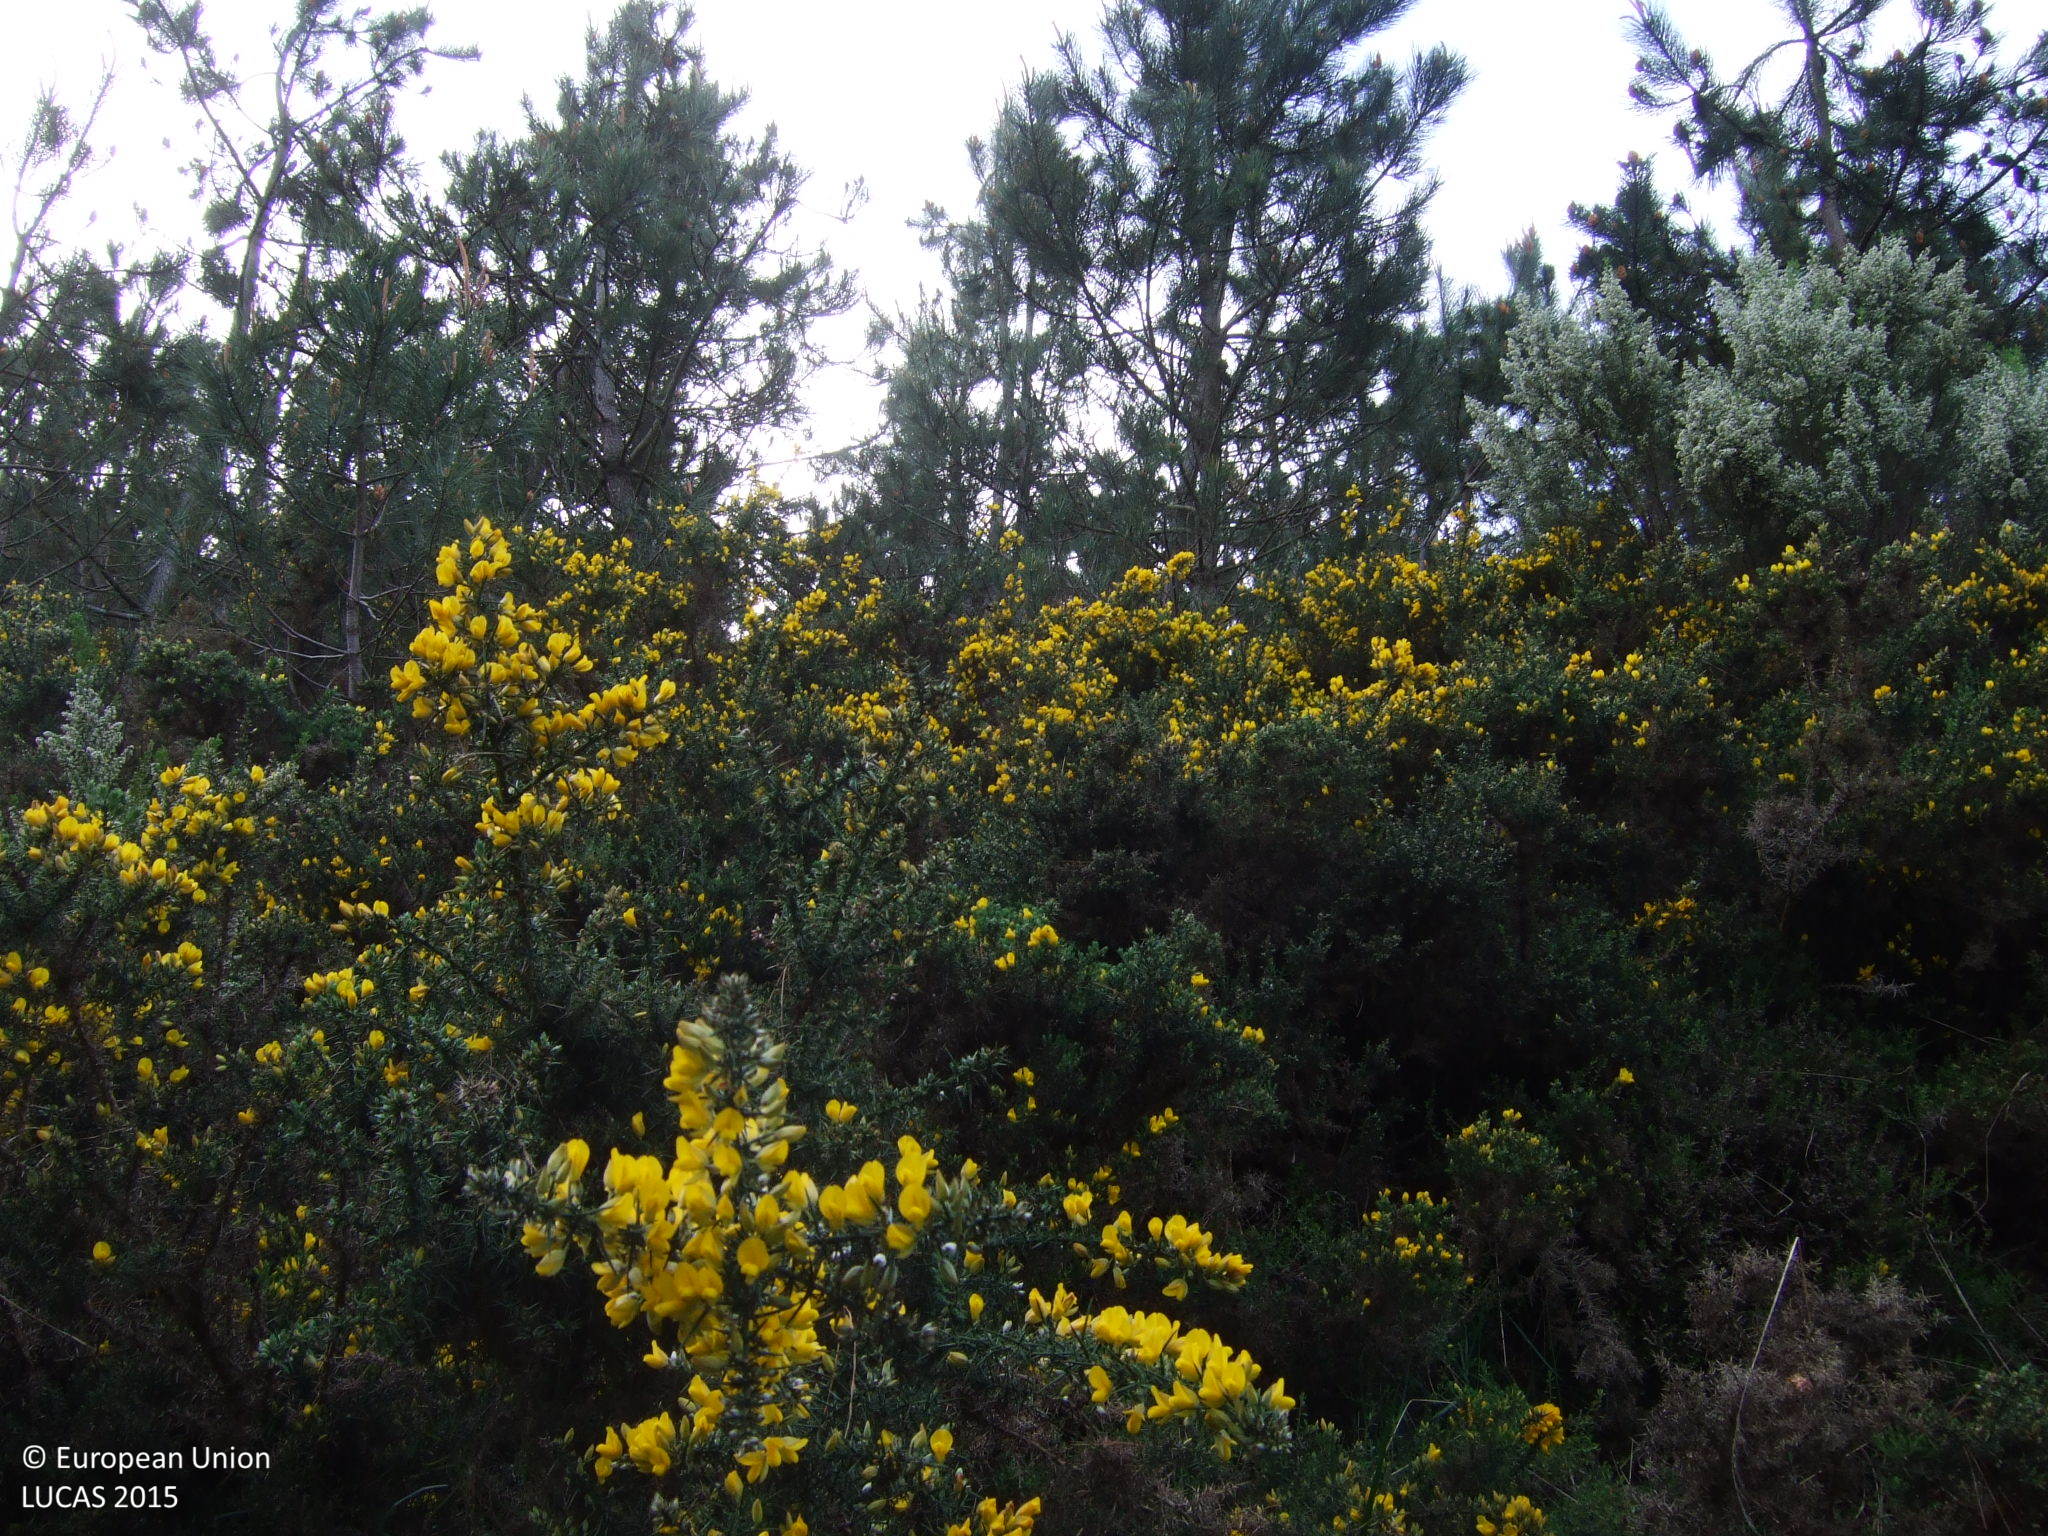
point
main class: Woodland
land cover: Pine dominated coniferous woodland
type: exotic forest
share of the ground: 25 - 50 %
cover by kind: shrubs 70 %, coniferous forest trees 30 %
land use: Forestry
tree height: > 5 m
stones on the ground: < 10 %
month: May
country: ES
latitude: 43.1237
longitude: -7.1905
